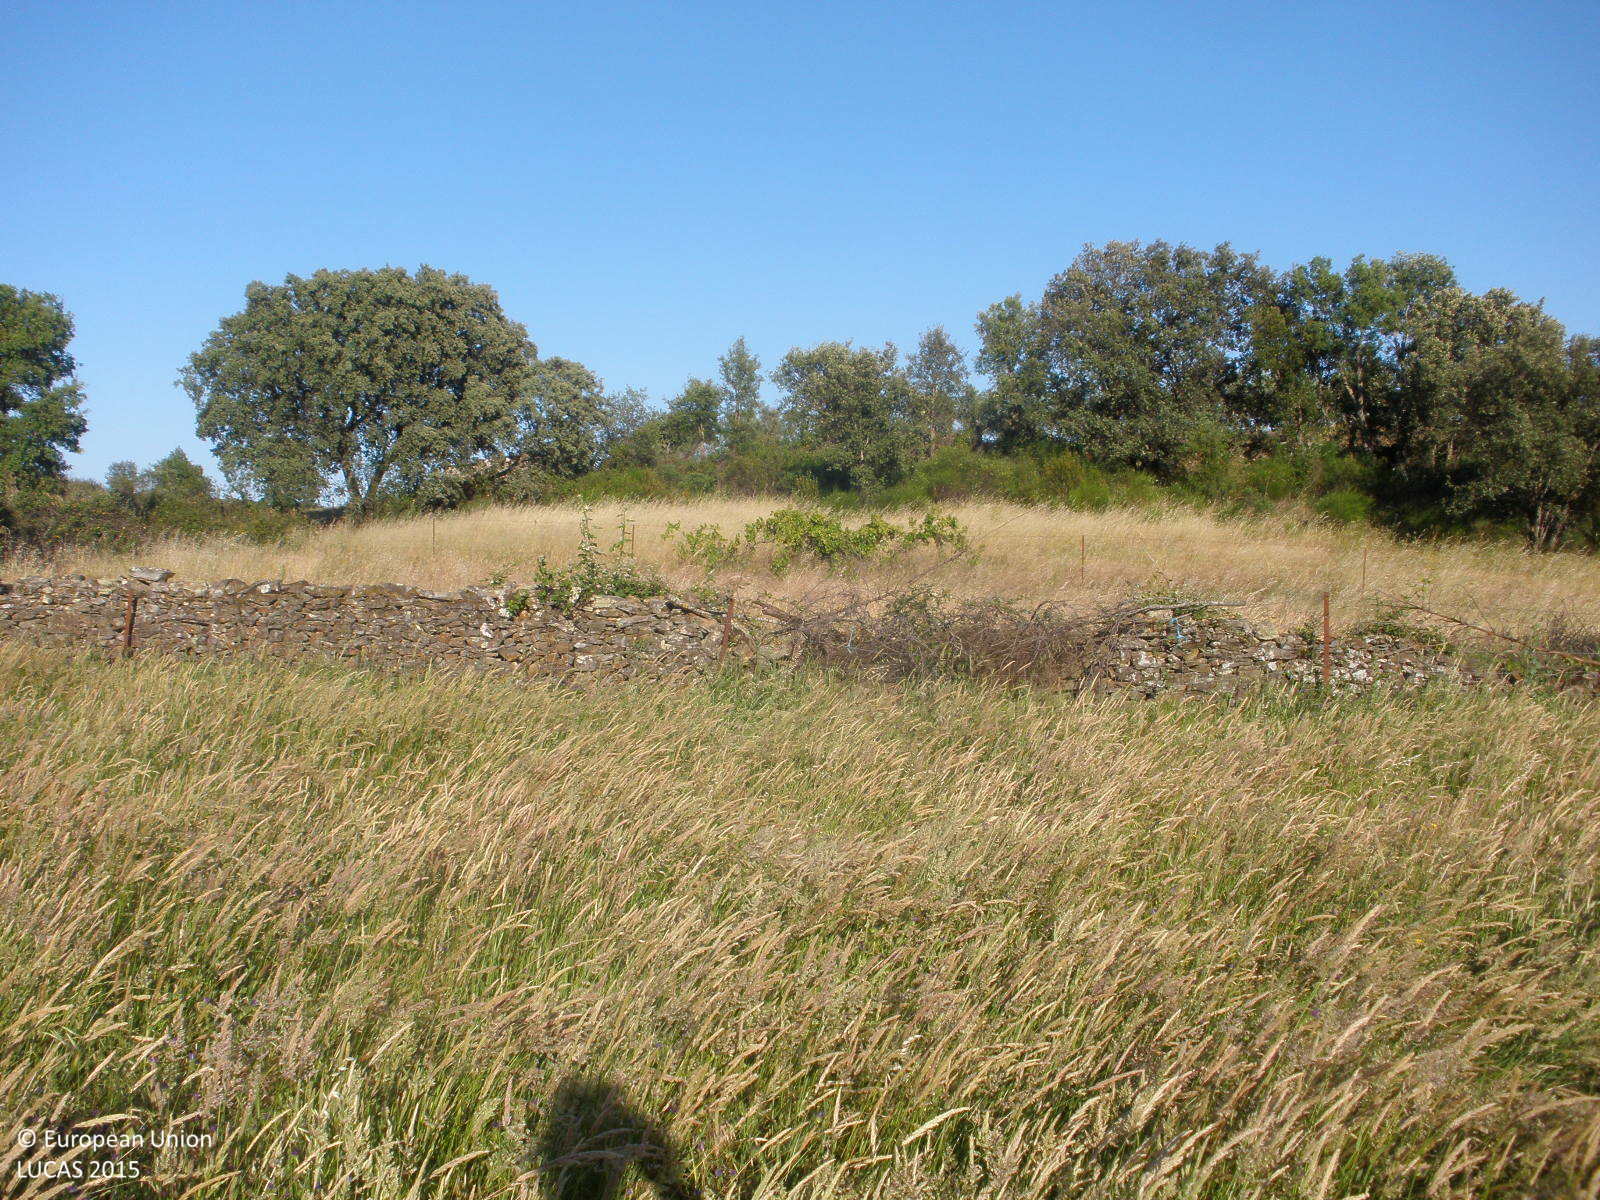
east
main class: Grassland
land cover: Spontaneously vegetated surfaces
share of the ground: > 75 %
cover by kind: herbaceous plants 100 %
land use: Fallow land
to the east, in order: Spontaneously vegetated surfaces; Fences; Dry stone walls; Spontaneously vegetated surfaces; Shruby margins; Dry stone walls; Tracks; Fences; Other bare soil; Dry stone walls; Shrubland without tree cover
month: May
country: ES
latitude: 40.2337
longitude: -6.2147
